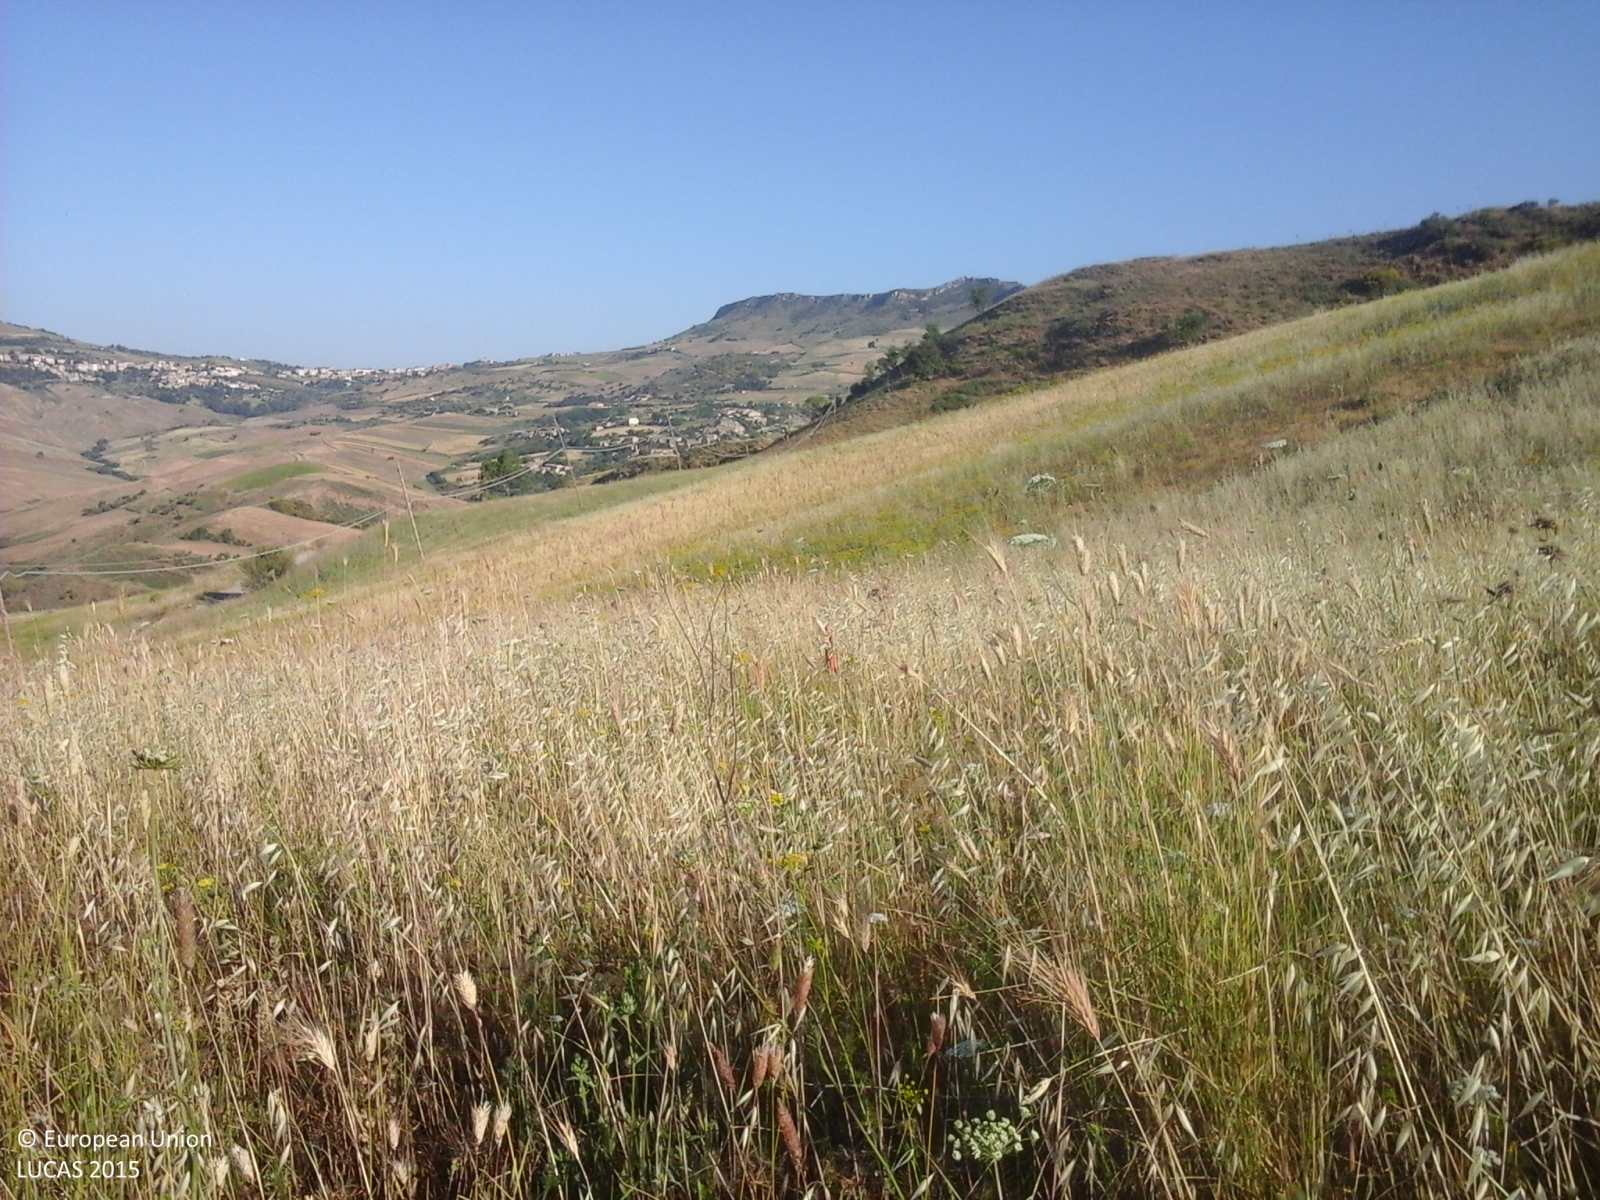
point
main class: Grassland
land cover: Grassland without tree/shrub cover
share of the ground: > 75 %
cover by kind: herbaceous plants 100 %
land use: Agriculture (excluding fallow land and kitchen gardens)
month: June
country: IT
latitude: 37.7666
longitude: 14.1365
